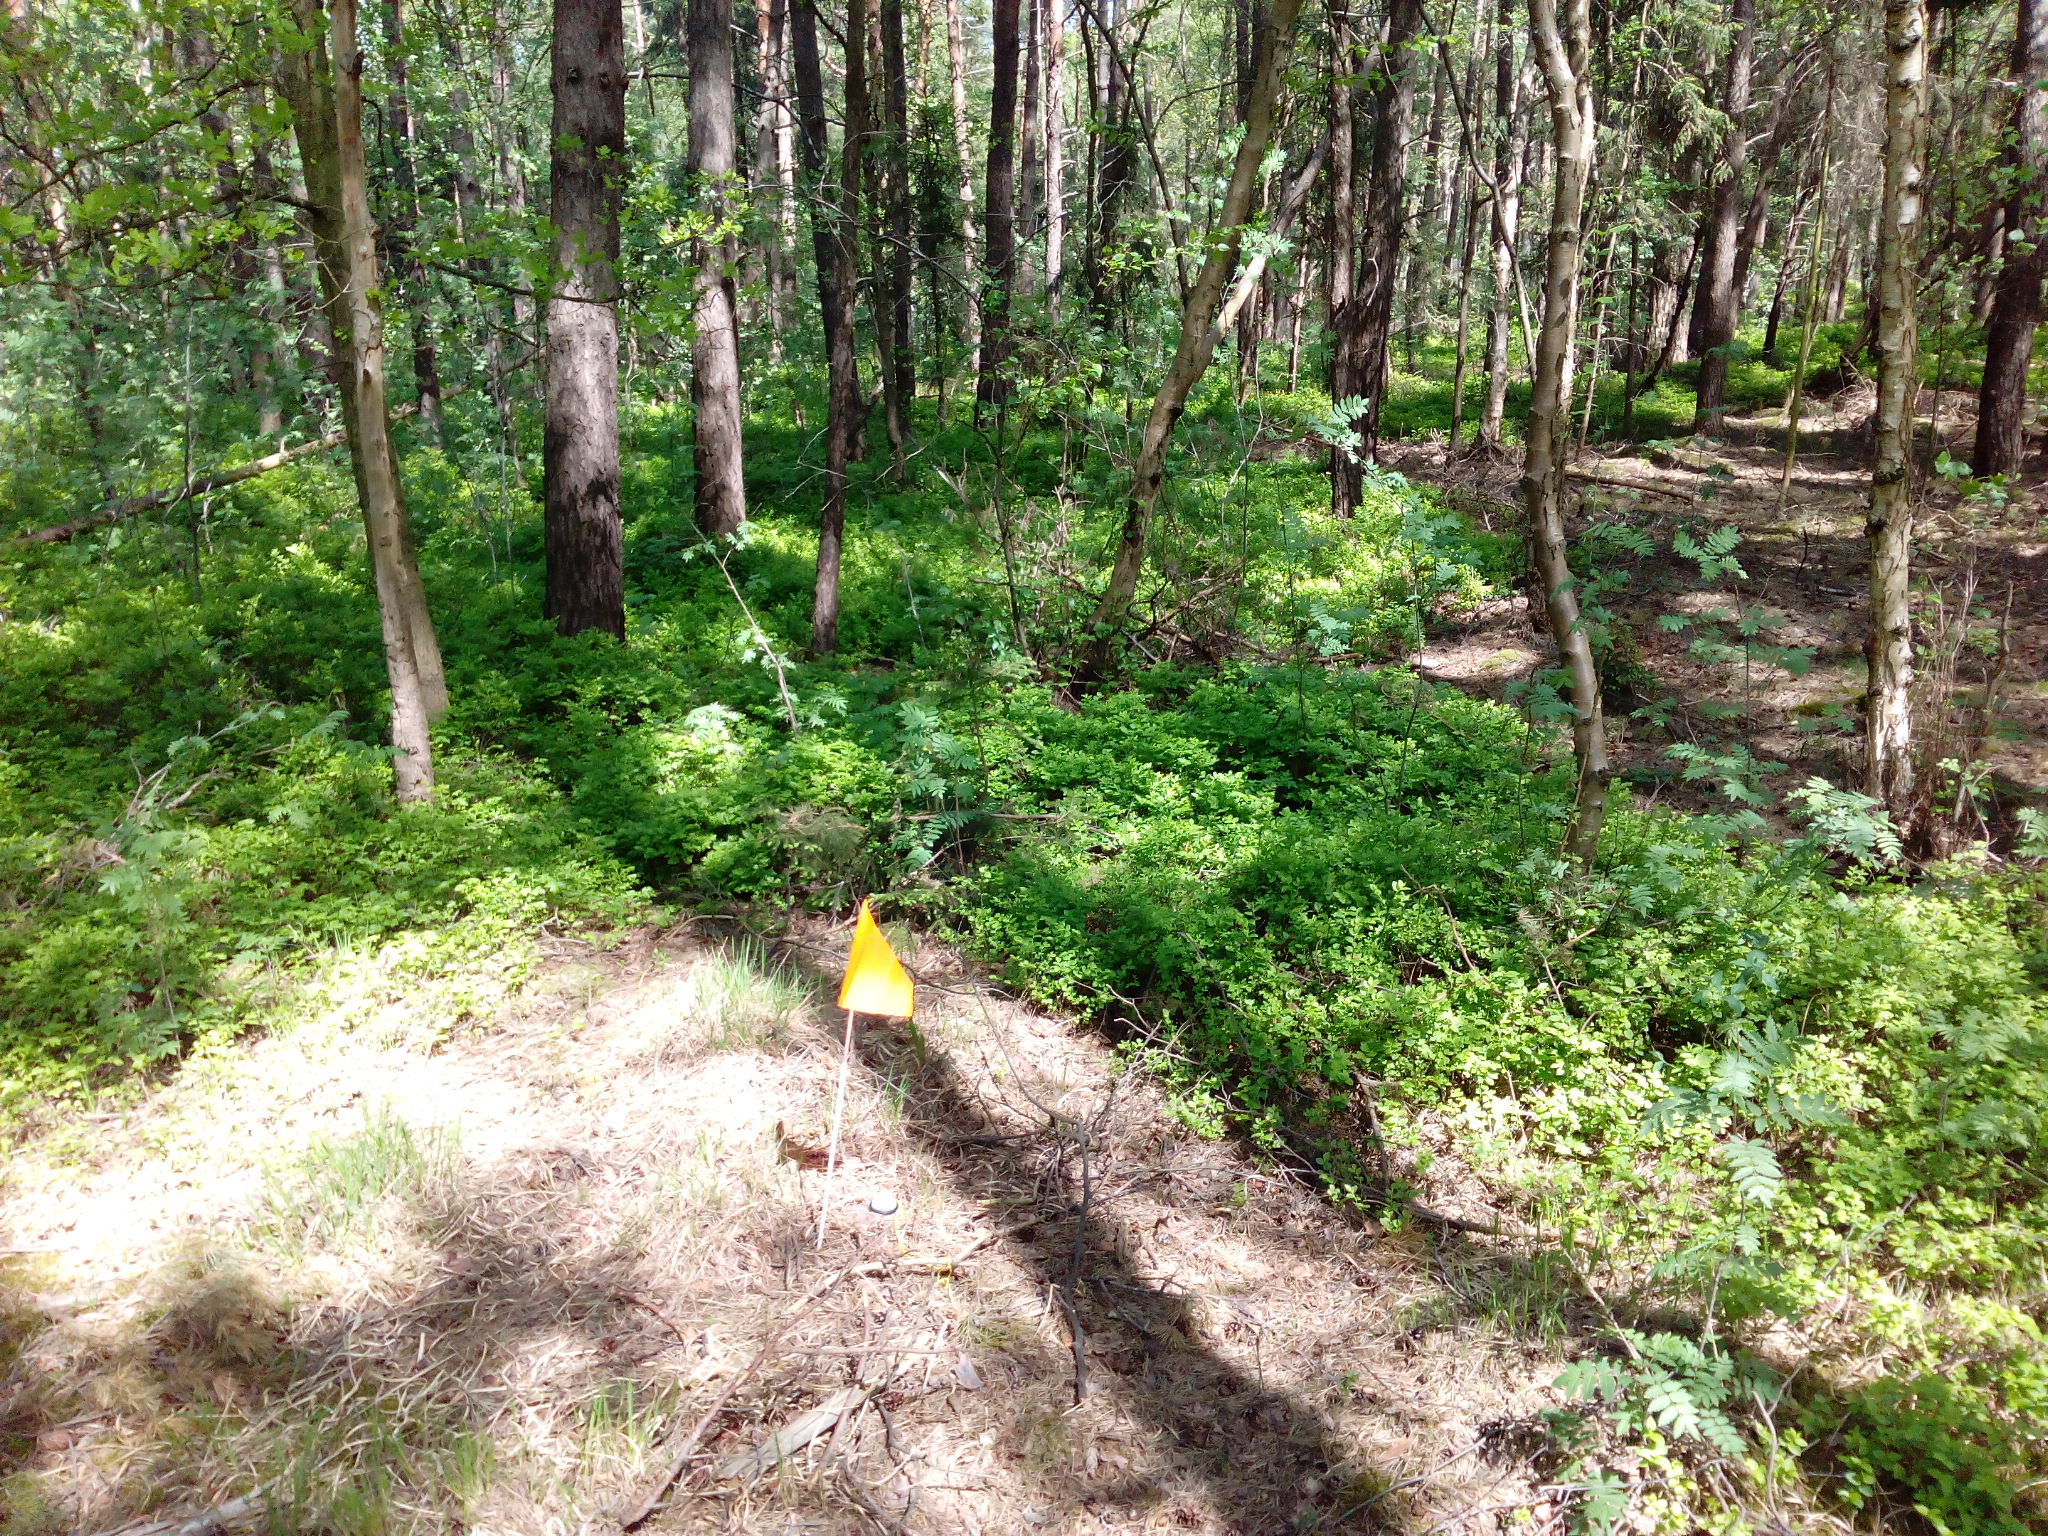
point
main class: Woodland
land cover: Pine dominated mixed woodland
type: hemiboreal forest and nemoral coniferous forest and mixed broadleaved-coniferous forest
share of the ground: > 75 %
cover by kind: coniferous forest trees 60 %, broadleaved forest trees 25 %, herbaceous plants 10 %, unconsolidated bare surface 5 %
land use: Forestry
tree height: > 5 m
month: May
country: DE
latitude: 52.4313
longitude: 9.8971
